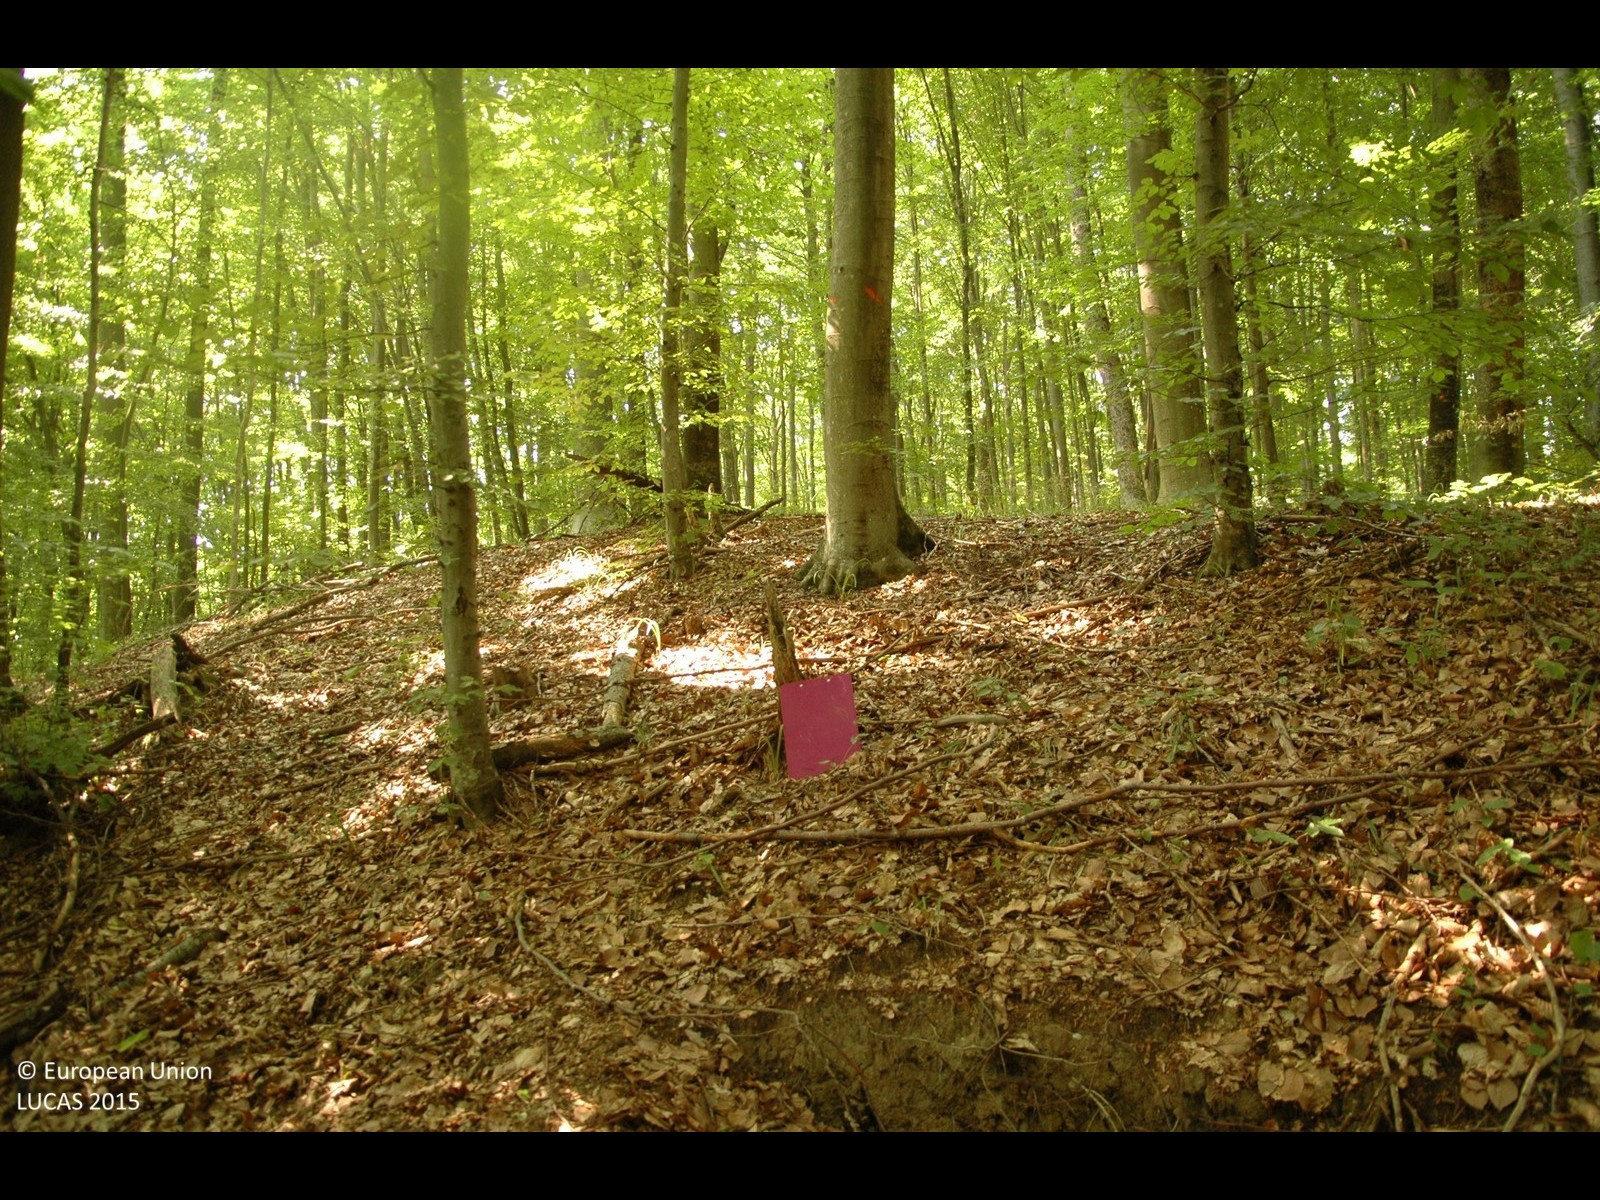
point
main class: Woodland
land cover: Broadleaved woodland
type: beech forest
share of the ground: > 75 %
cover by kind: broadleaved forest trees 100 %
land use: Forestry
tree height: > 5 m
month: July
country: HR
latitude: 46.1511
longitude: 16.5389
